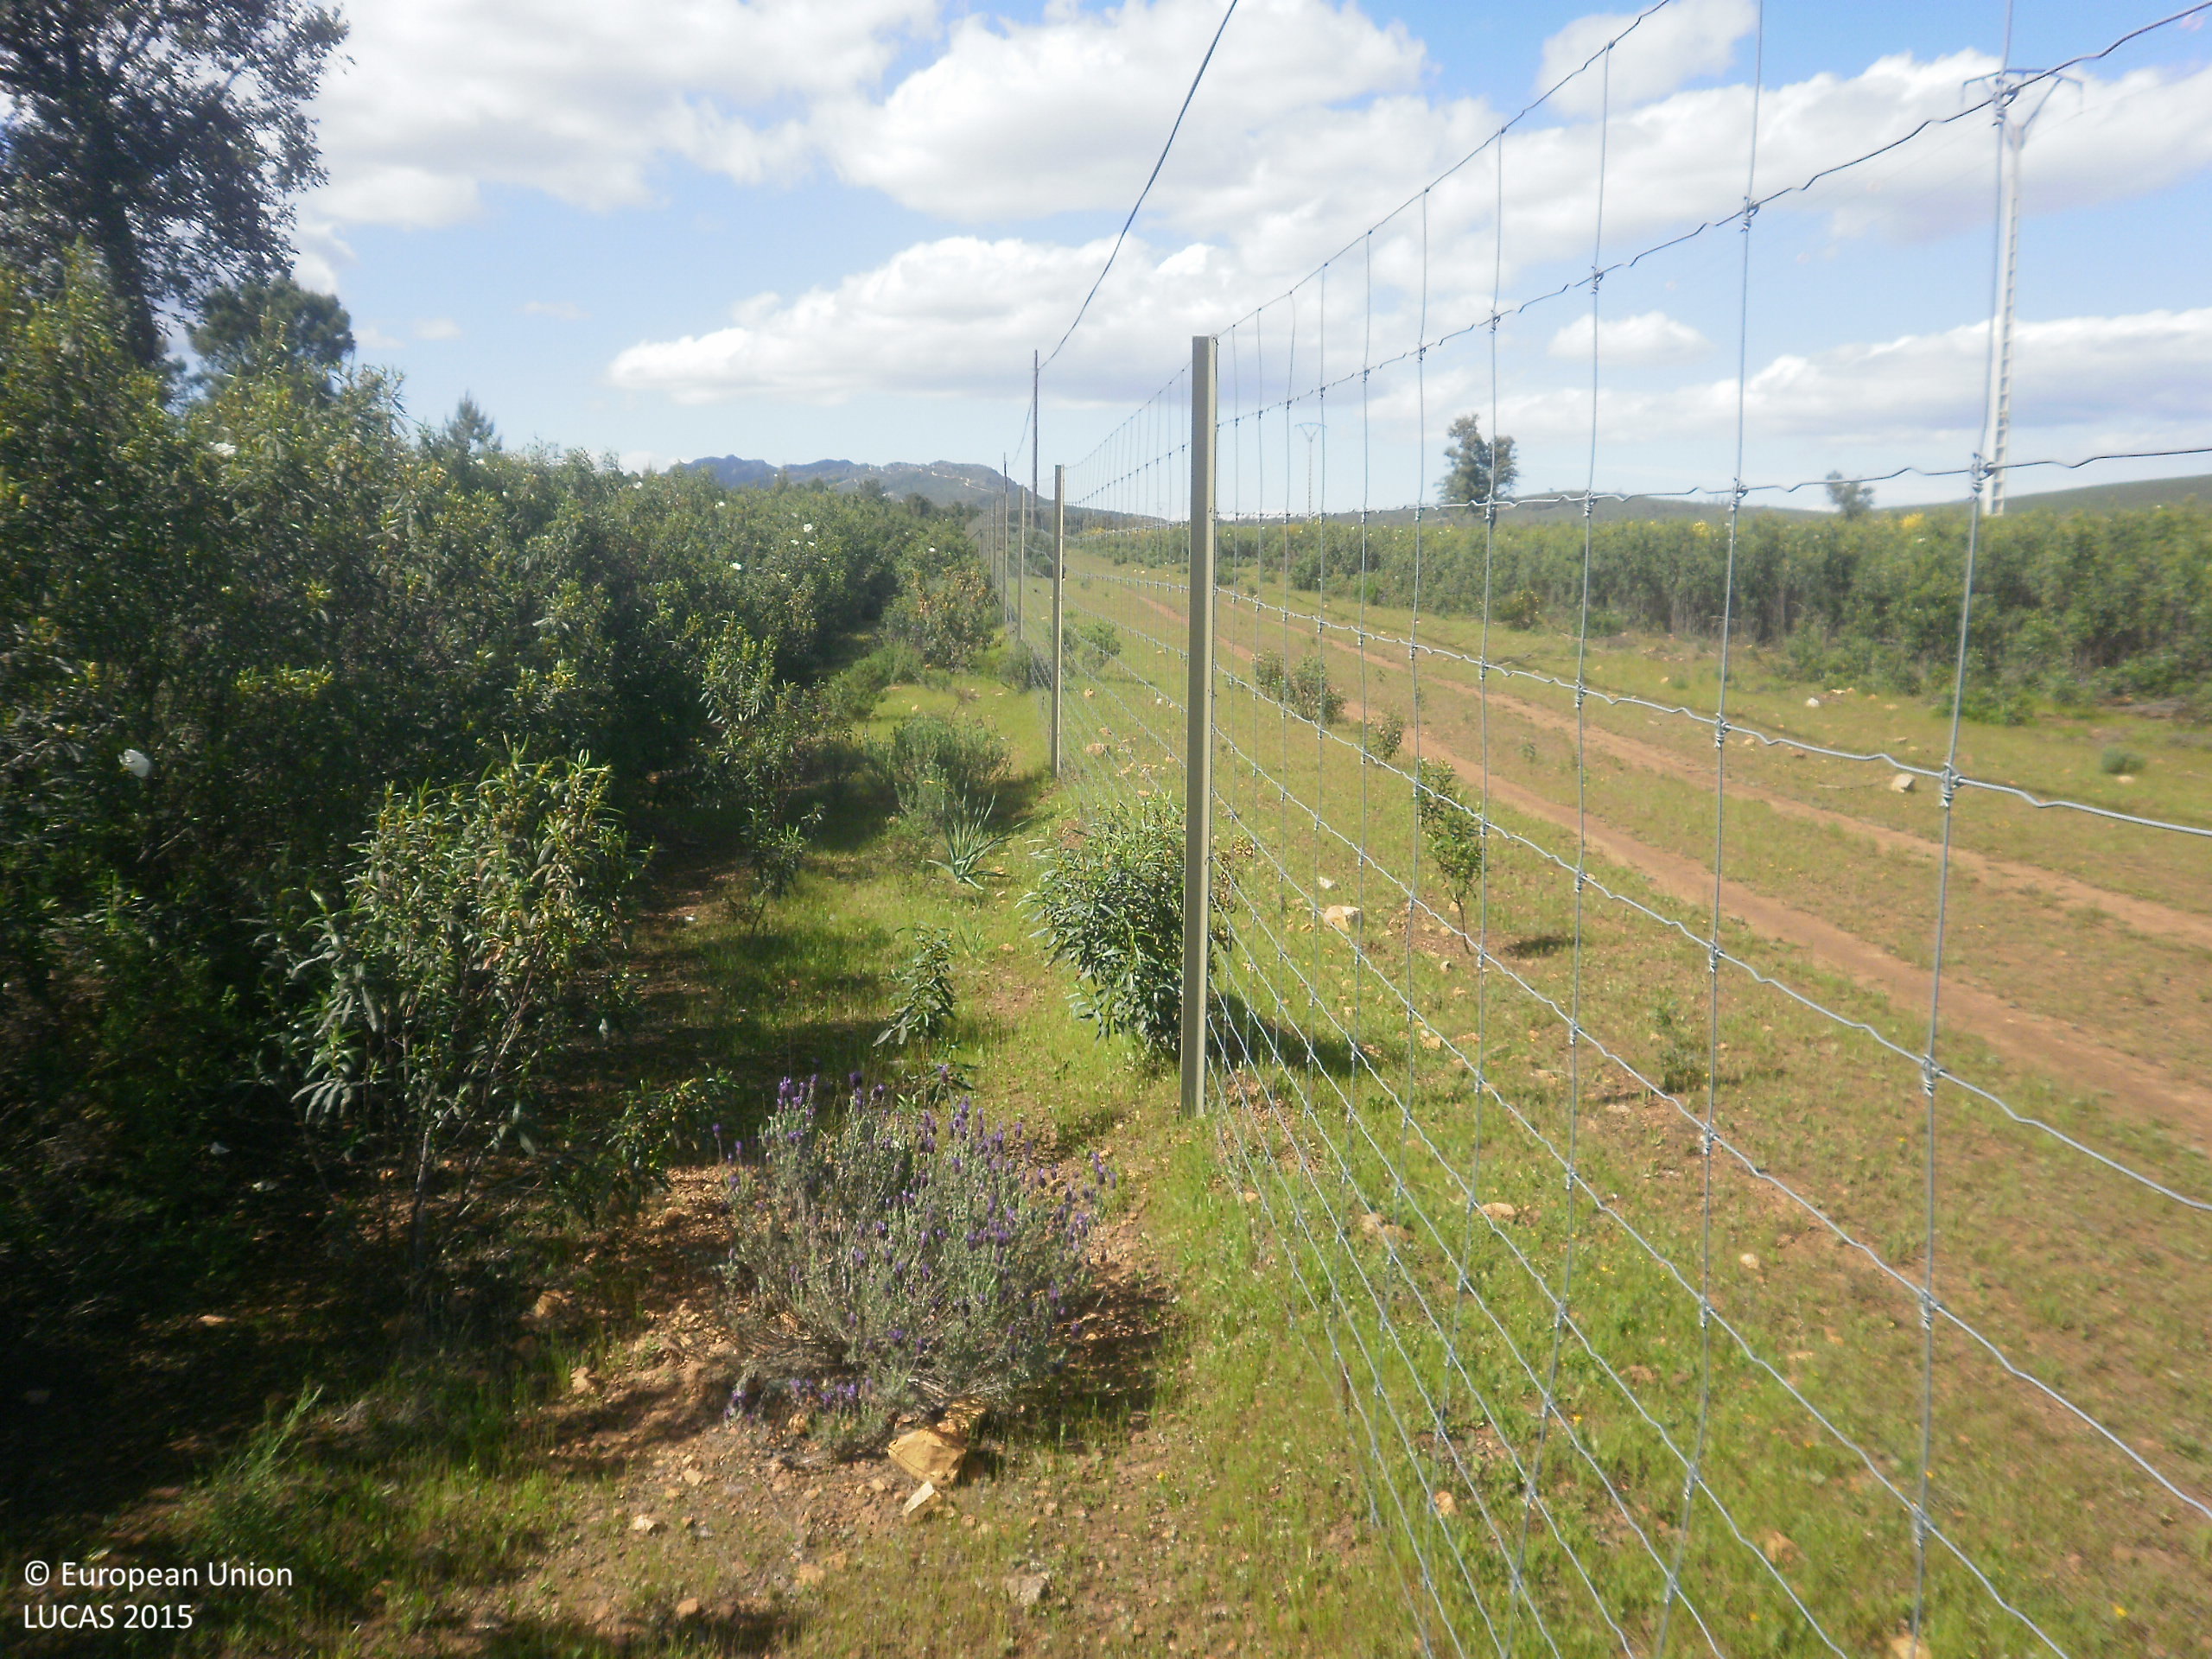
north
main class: Shrubland
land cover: Shrubland with sparse tree cover
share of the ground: > 75 %
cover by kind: shrubs 95 %, broadleaved forest trees 5 %
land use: Semi-natural and natural areas not in use
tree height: > 5 m
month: April
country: ES
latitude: 39.4168
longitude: -5.0144
